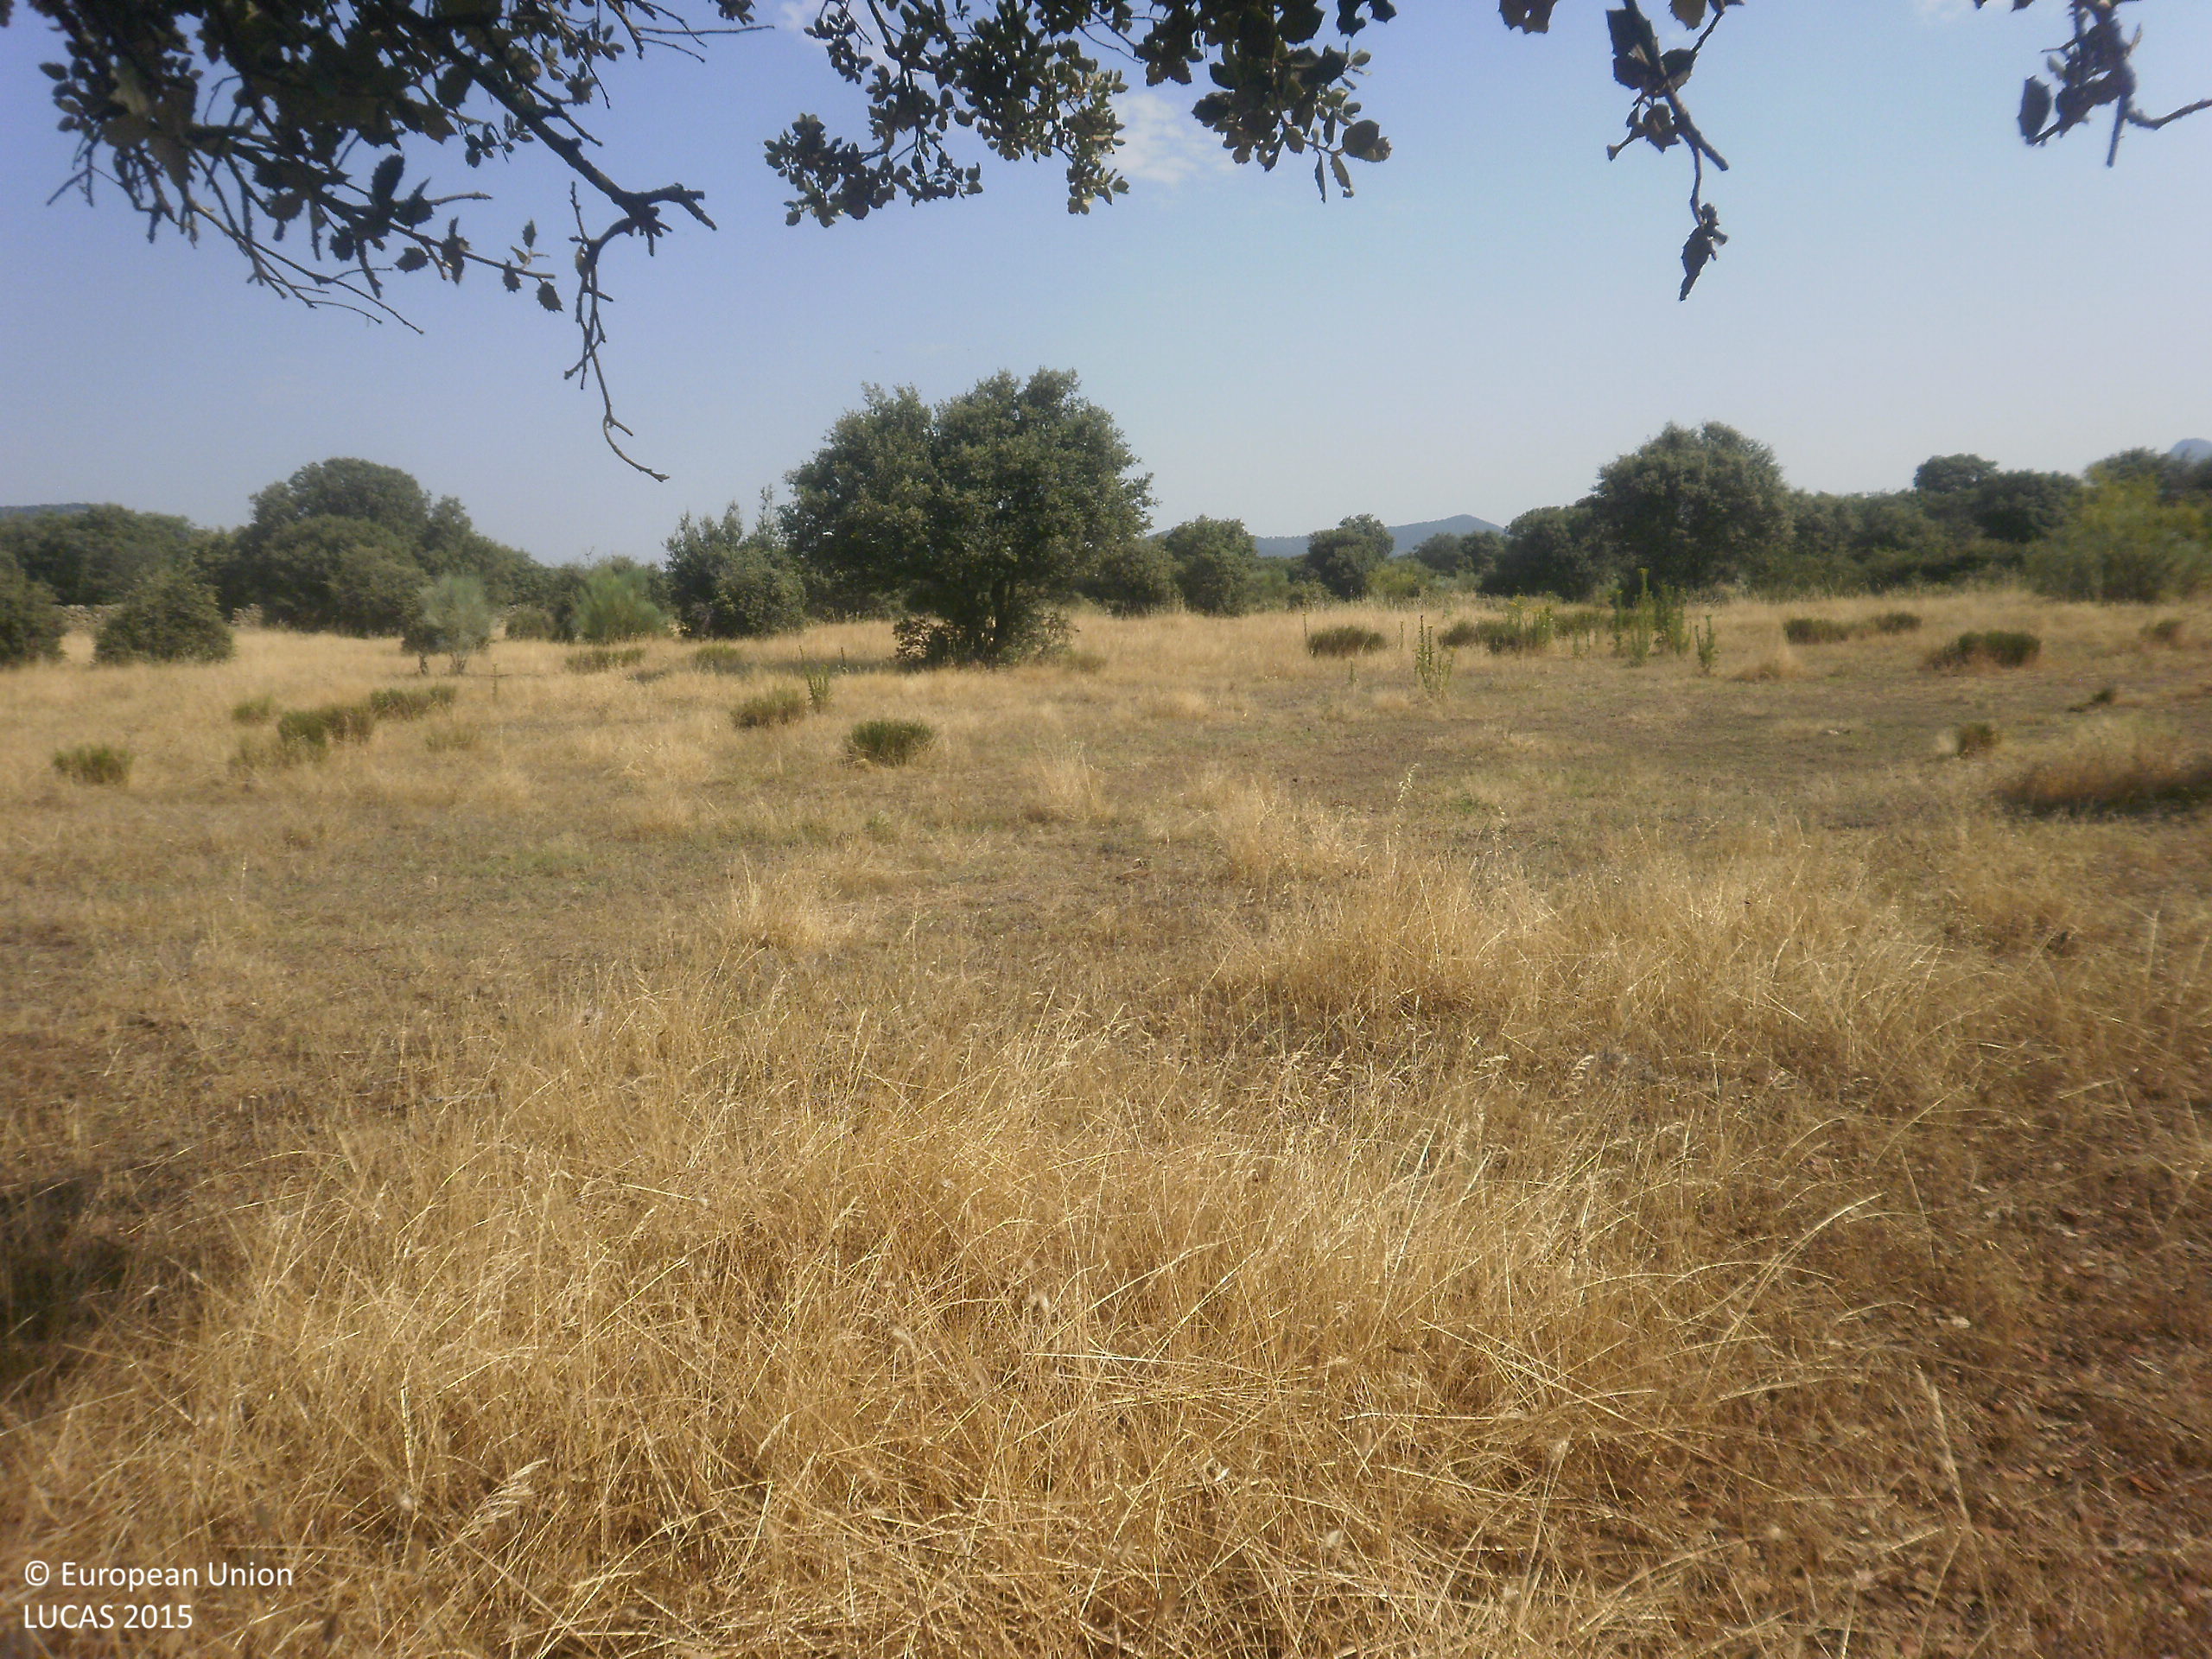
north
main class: Woodland
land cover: Broadleaved woodland
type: broadleaved evergreen forest
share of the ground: 10 - 25 %
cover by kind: herbaceous plants 80 %, broadleaved forest trees 15 %, shrubs 5 %
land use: Forestry
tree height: > 5 m
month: June
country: ES
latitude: 39.2563
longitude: -5.8967
